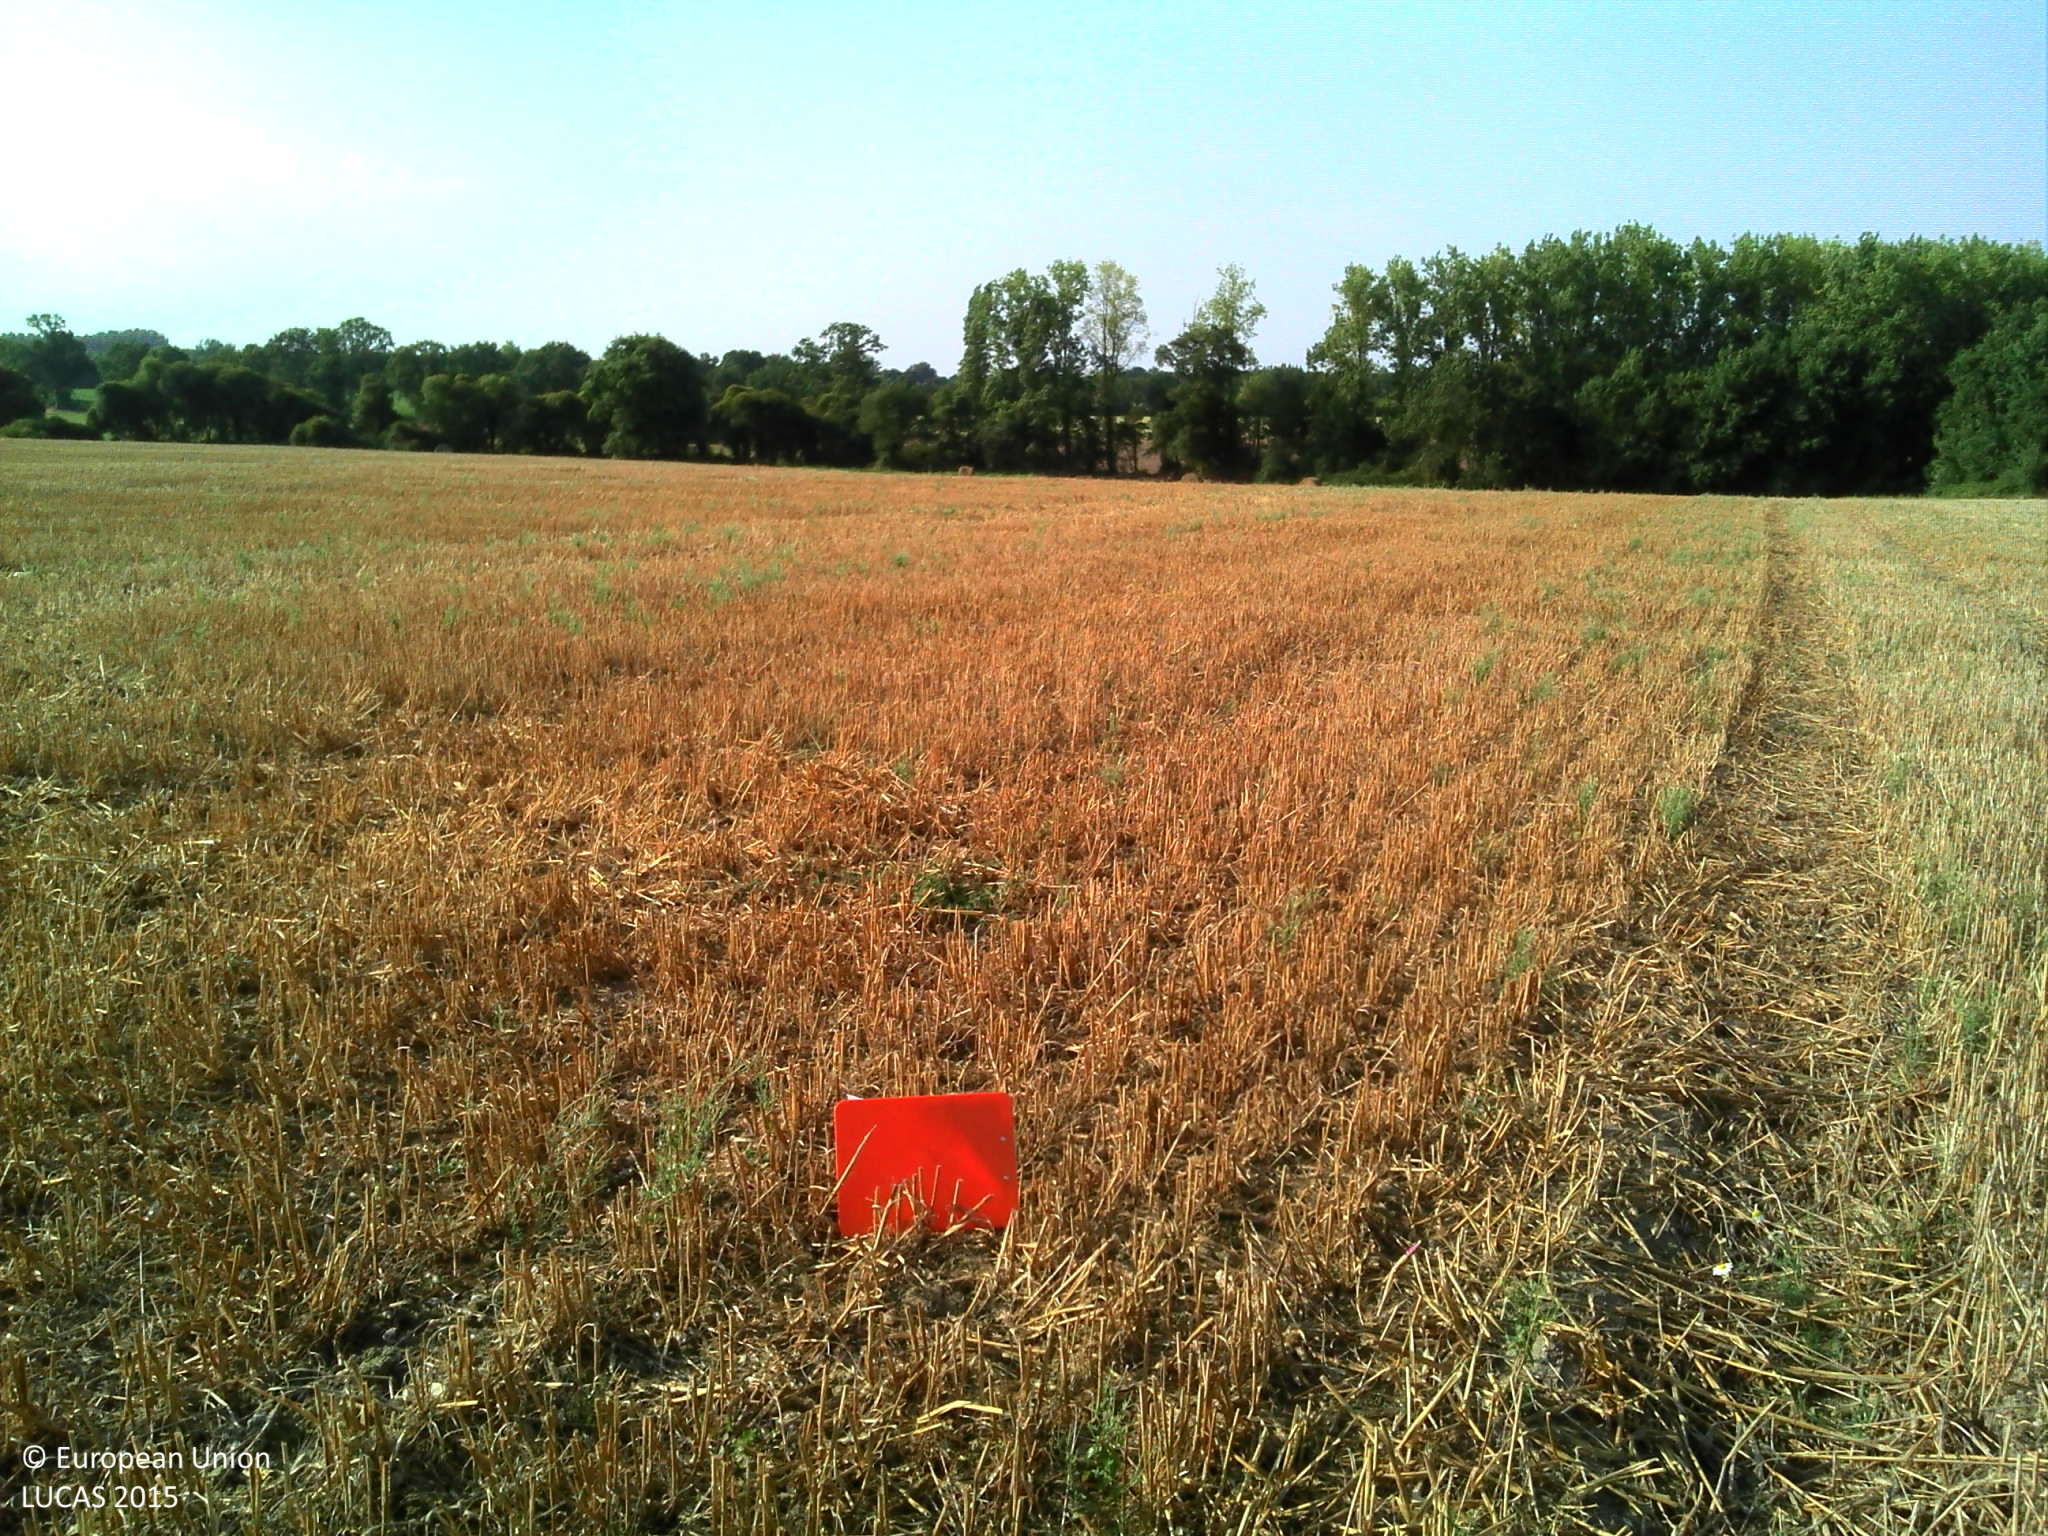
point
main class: Cropland
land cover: Triticale
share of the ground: > 75 %
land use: Agriculture (excluding fallow land and kitchen gardens)
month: August
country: FR
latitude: 46.9468
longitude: -1.6695
